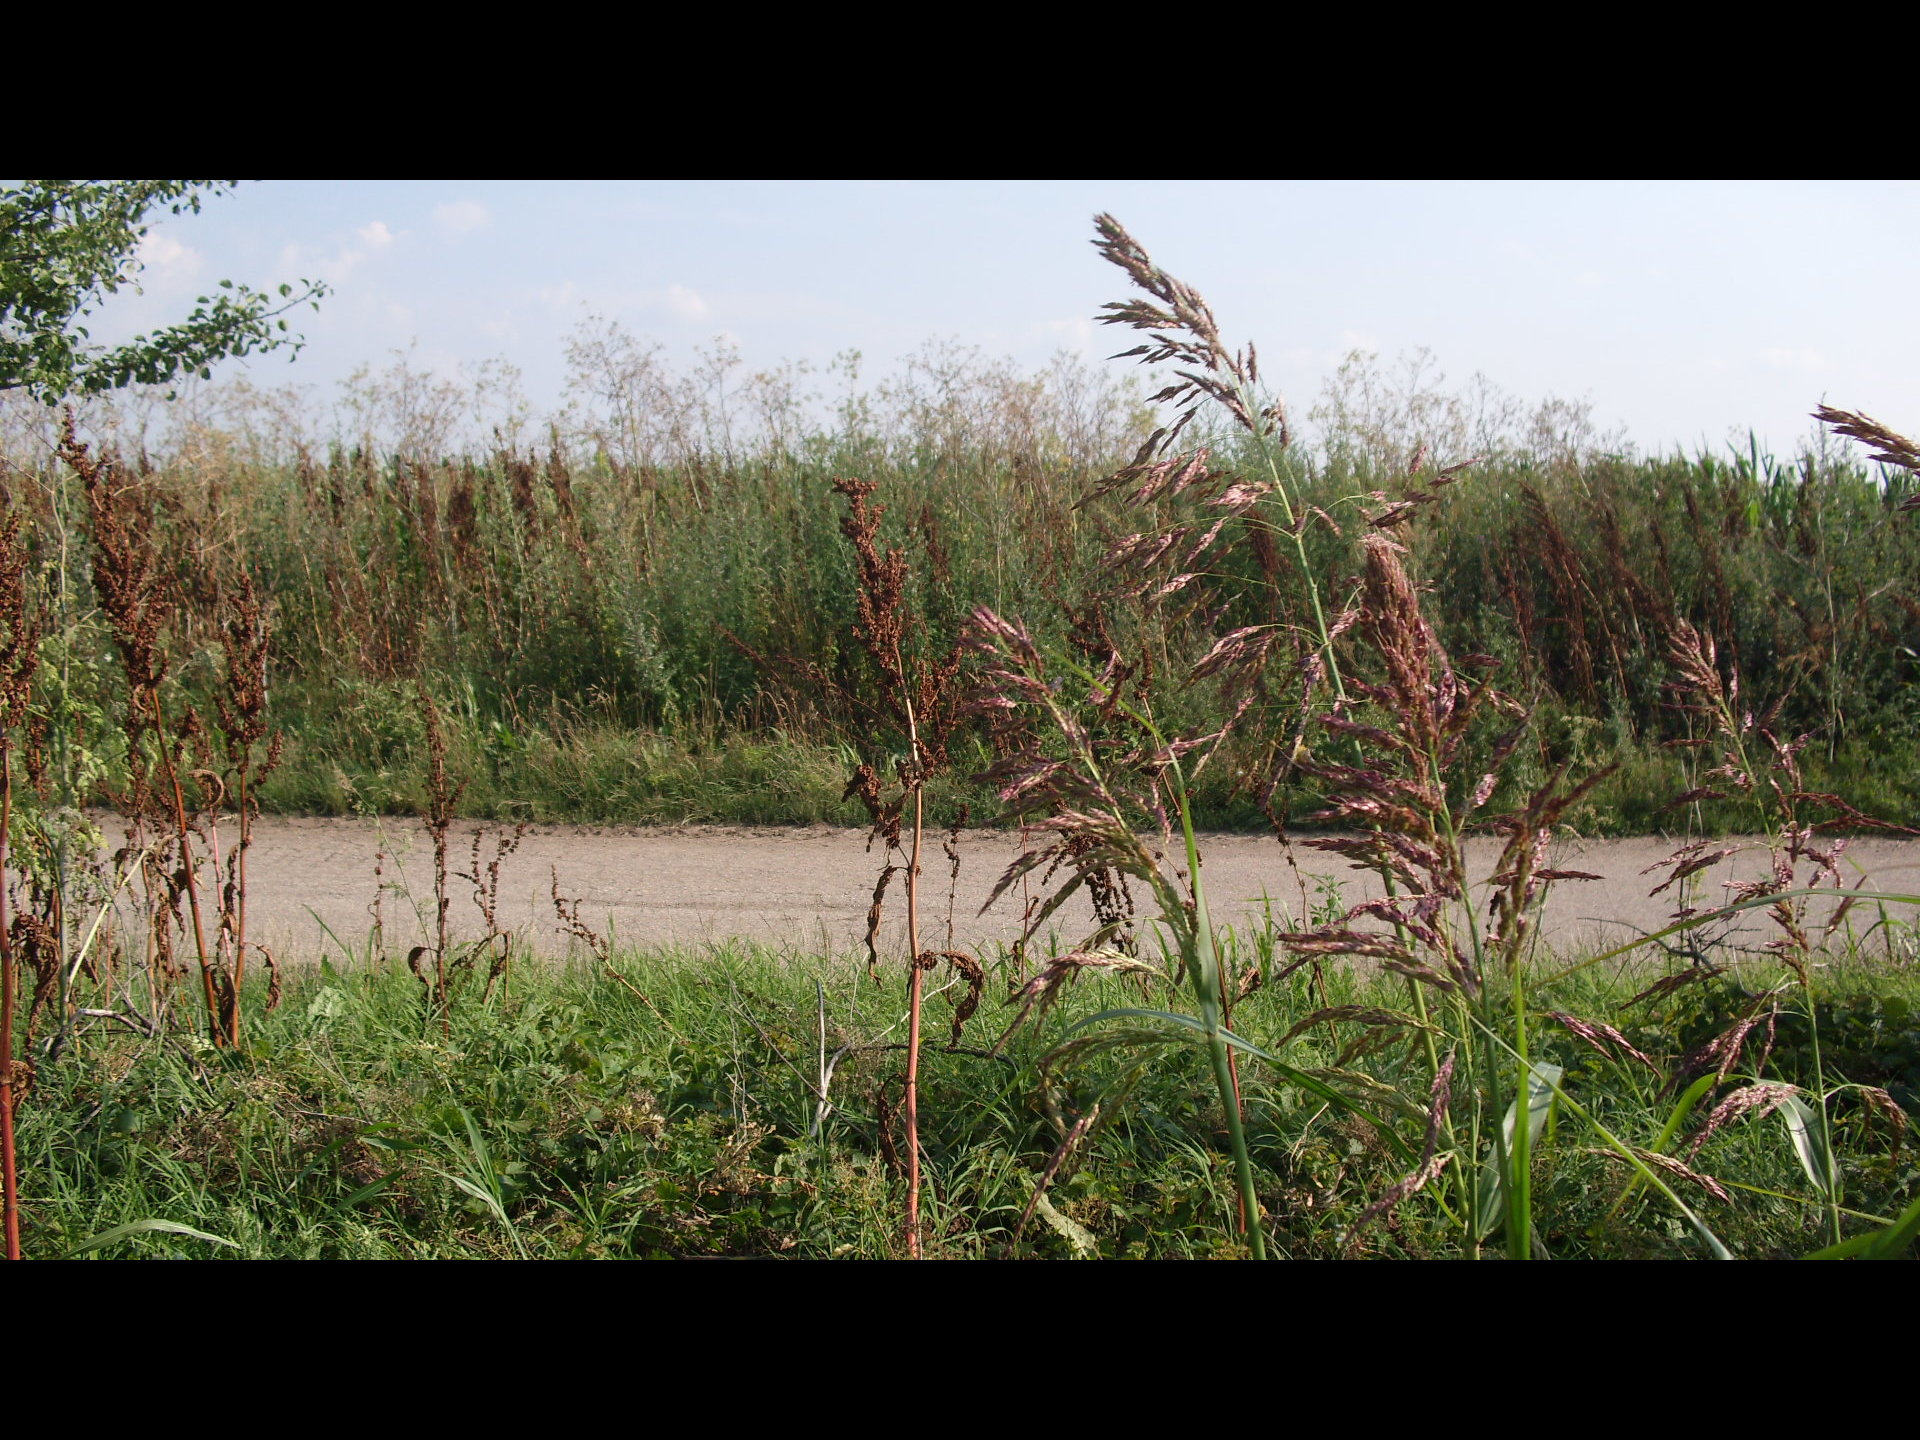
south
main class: Cropland
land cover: Sunflower
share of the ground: > 75 %
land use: Agriculture (excluding fallow land and kitchen gardens)
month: June
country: BG
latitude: 43.6822
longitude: 23.5056
